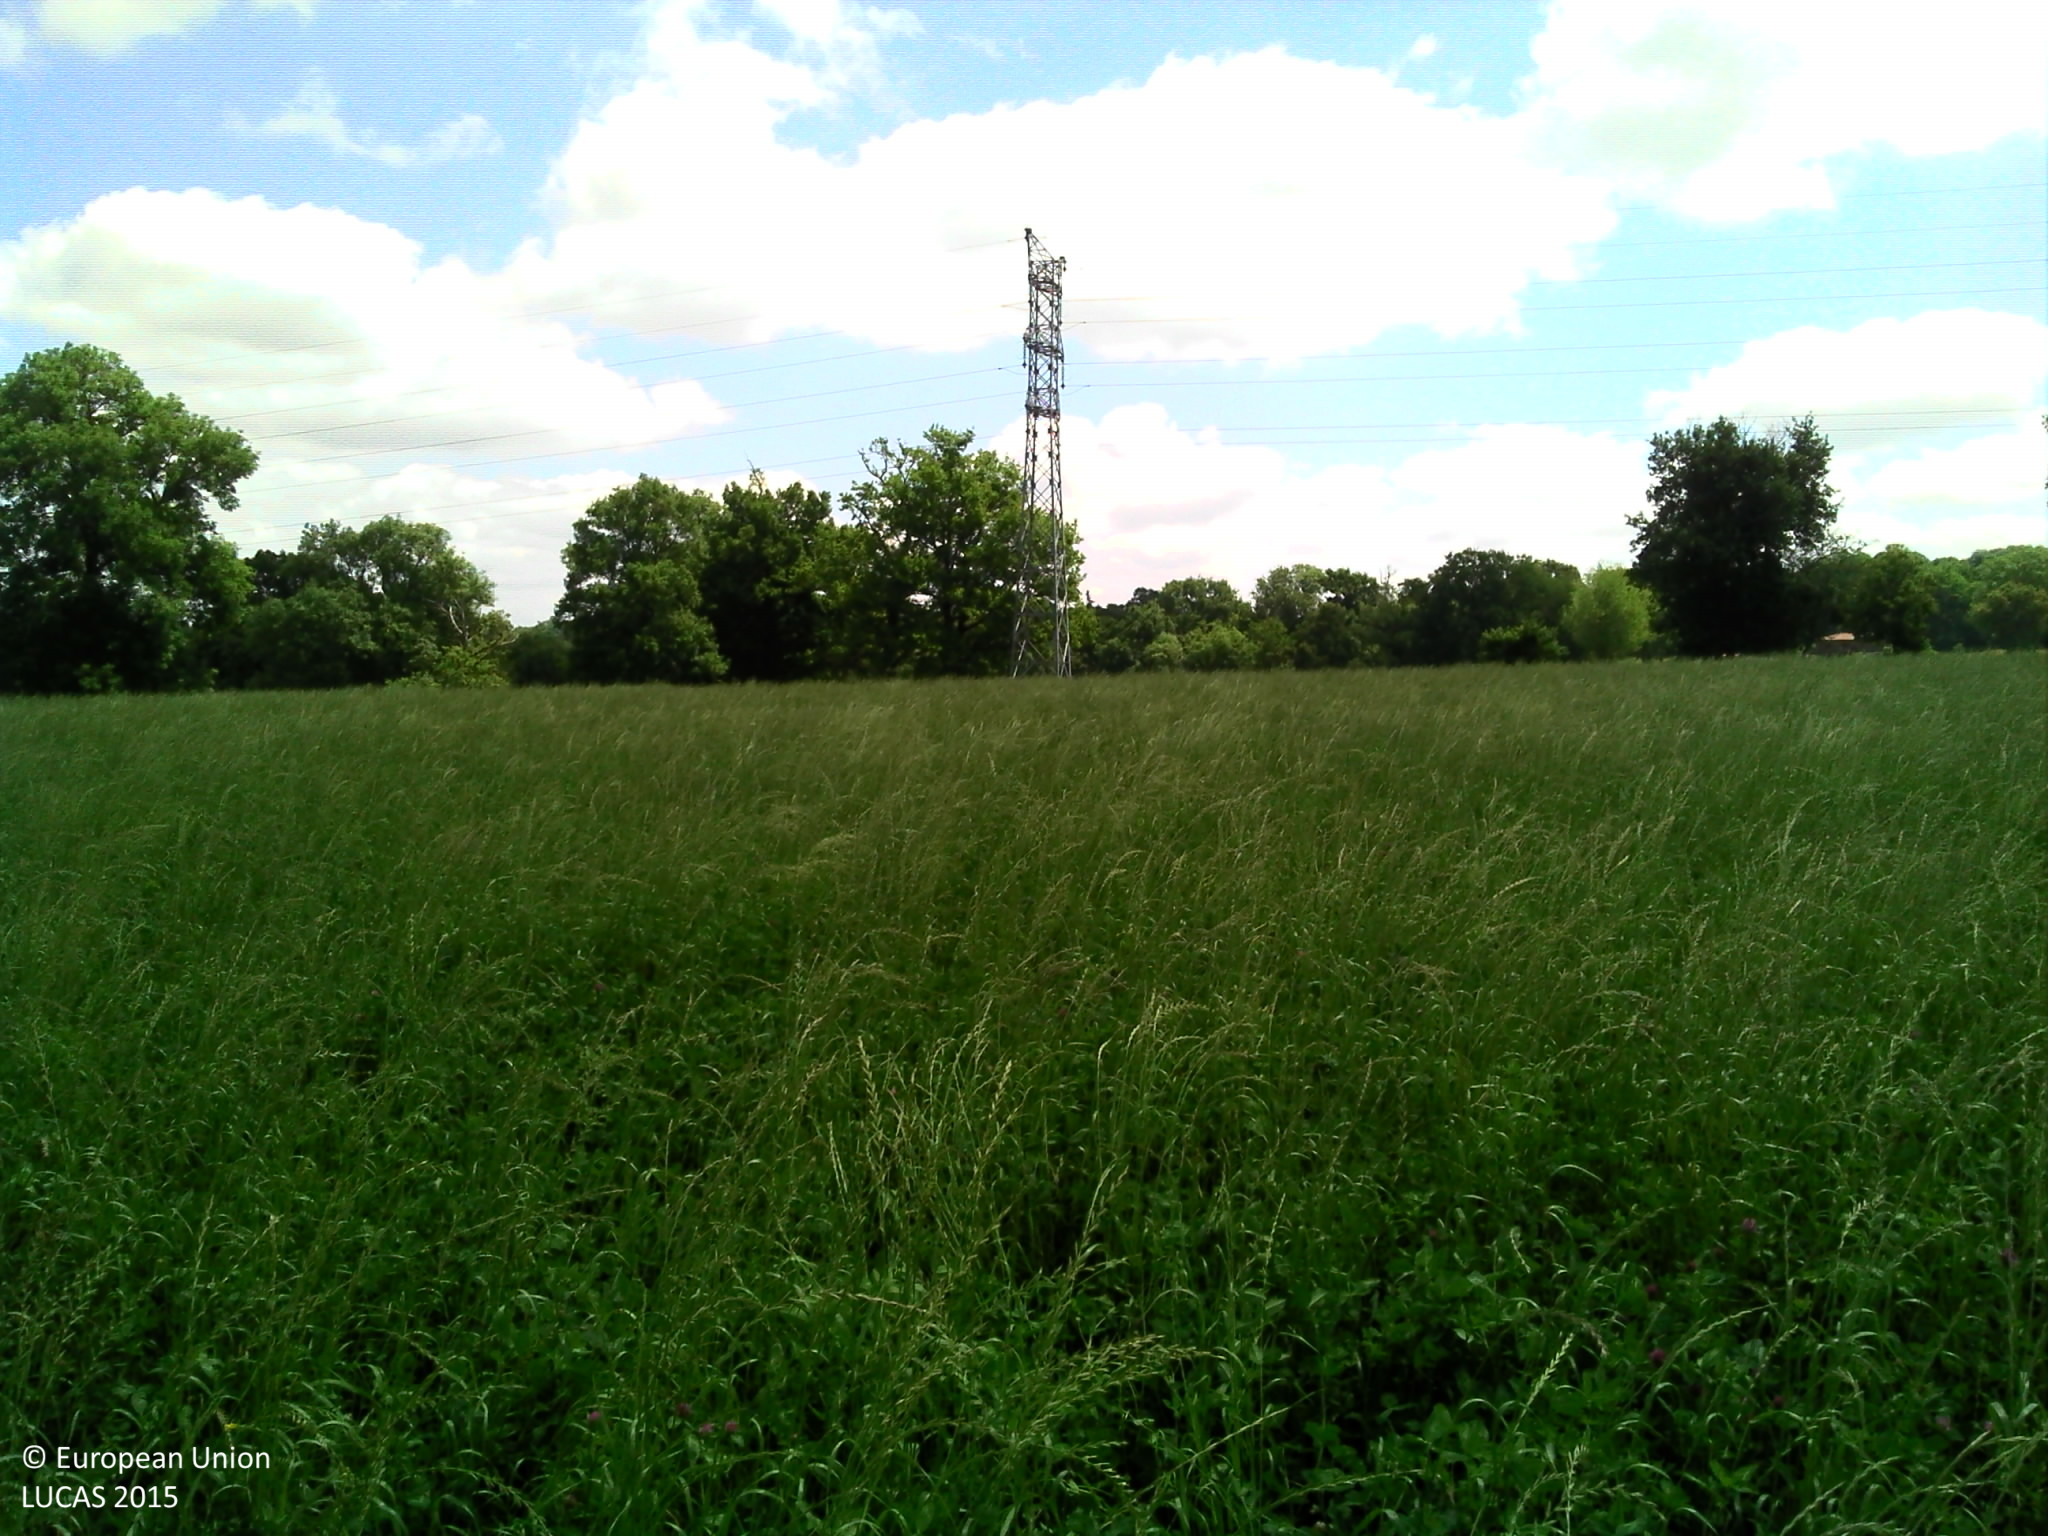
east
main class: Cropland
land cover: Temporary grasslands
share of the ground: > 75 %
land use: Agriculture (excluding fallow land and kitchen gardens)
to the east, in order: Temporary grasslands; Electric lines; Tracks; Fences; Grassland without tree/shrub cover
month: June
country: FR
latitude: 45.9775
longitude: 0.6541
